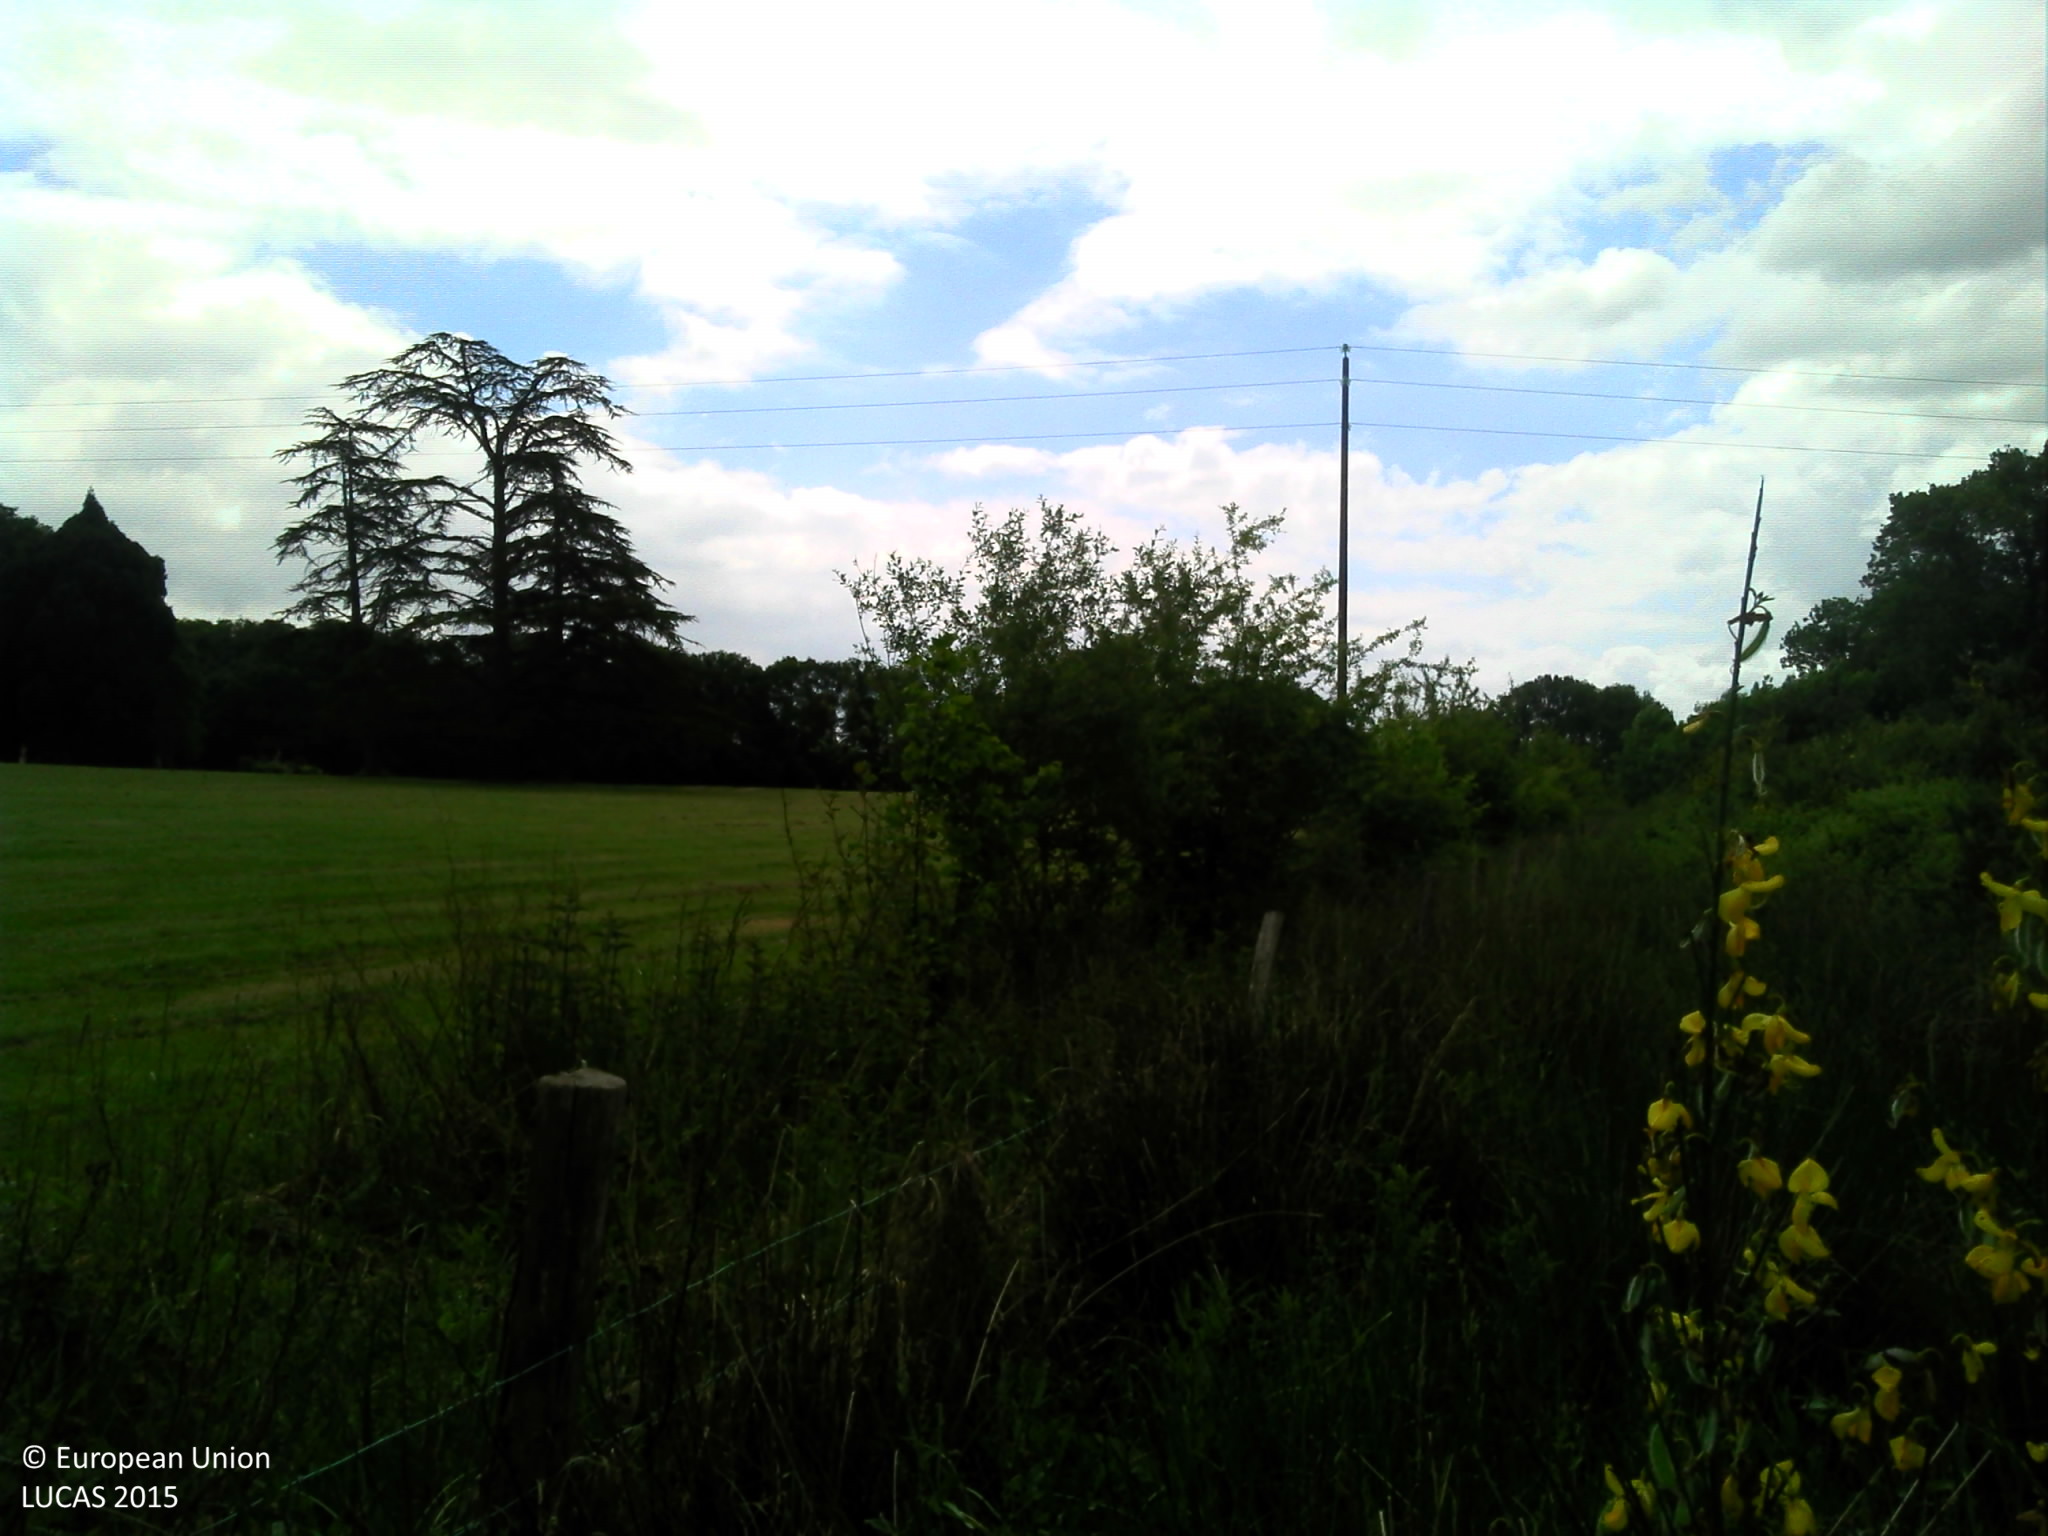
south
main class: Shrubland
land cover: Shrubland with sparse tree cover
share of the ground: > 75 %
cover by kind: shrubs 90 %, broadleaved forest trees 5 %, herbaceous plants 5 %
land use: Abandoned areas
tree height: < 5 m
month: May
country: FR
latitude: 47.5973
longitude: 0.7368
